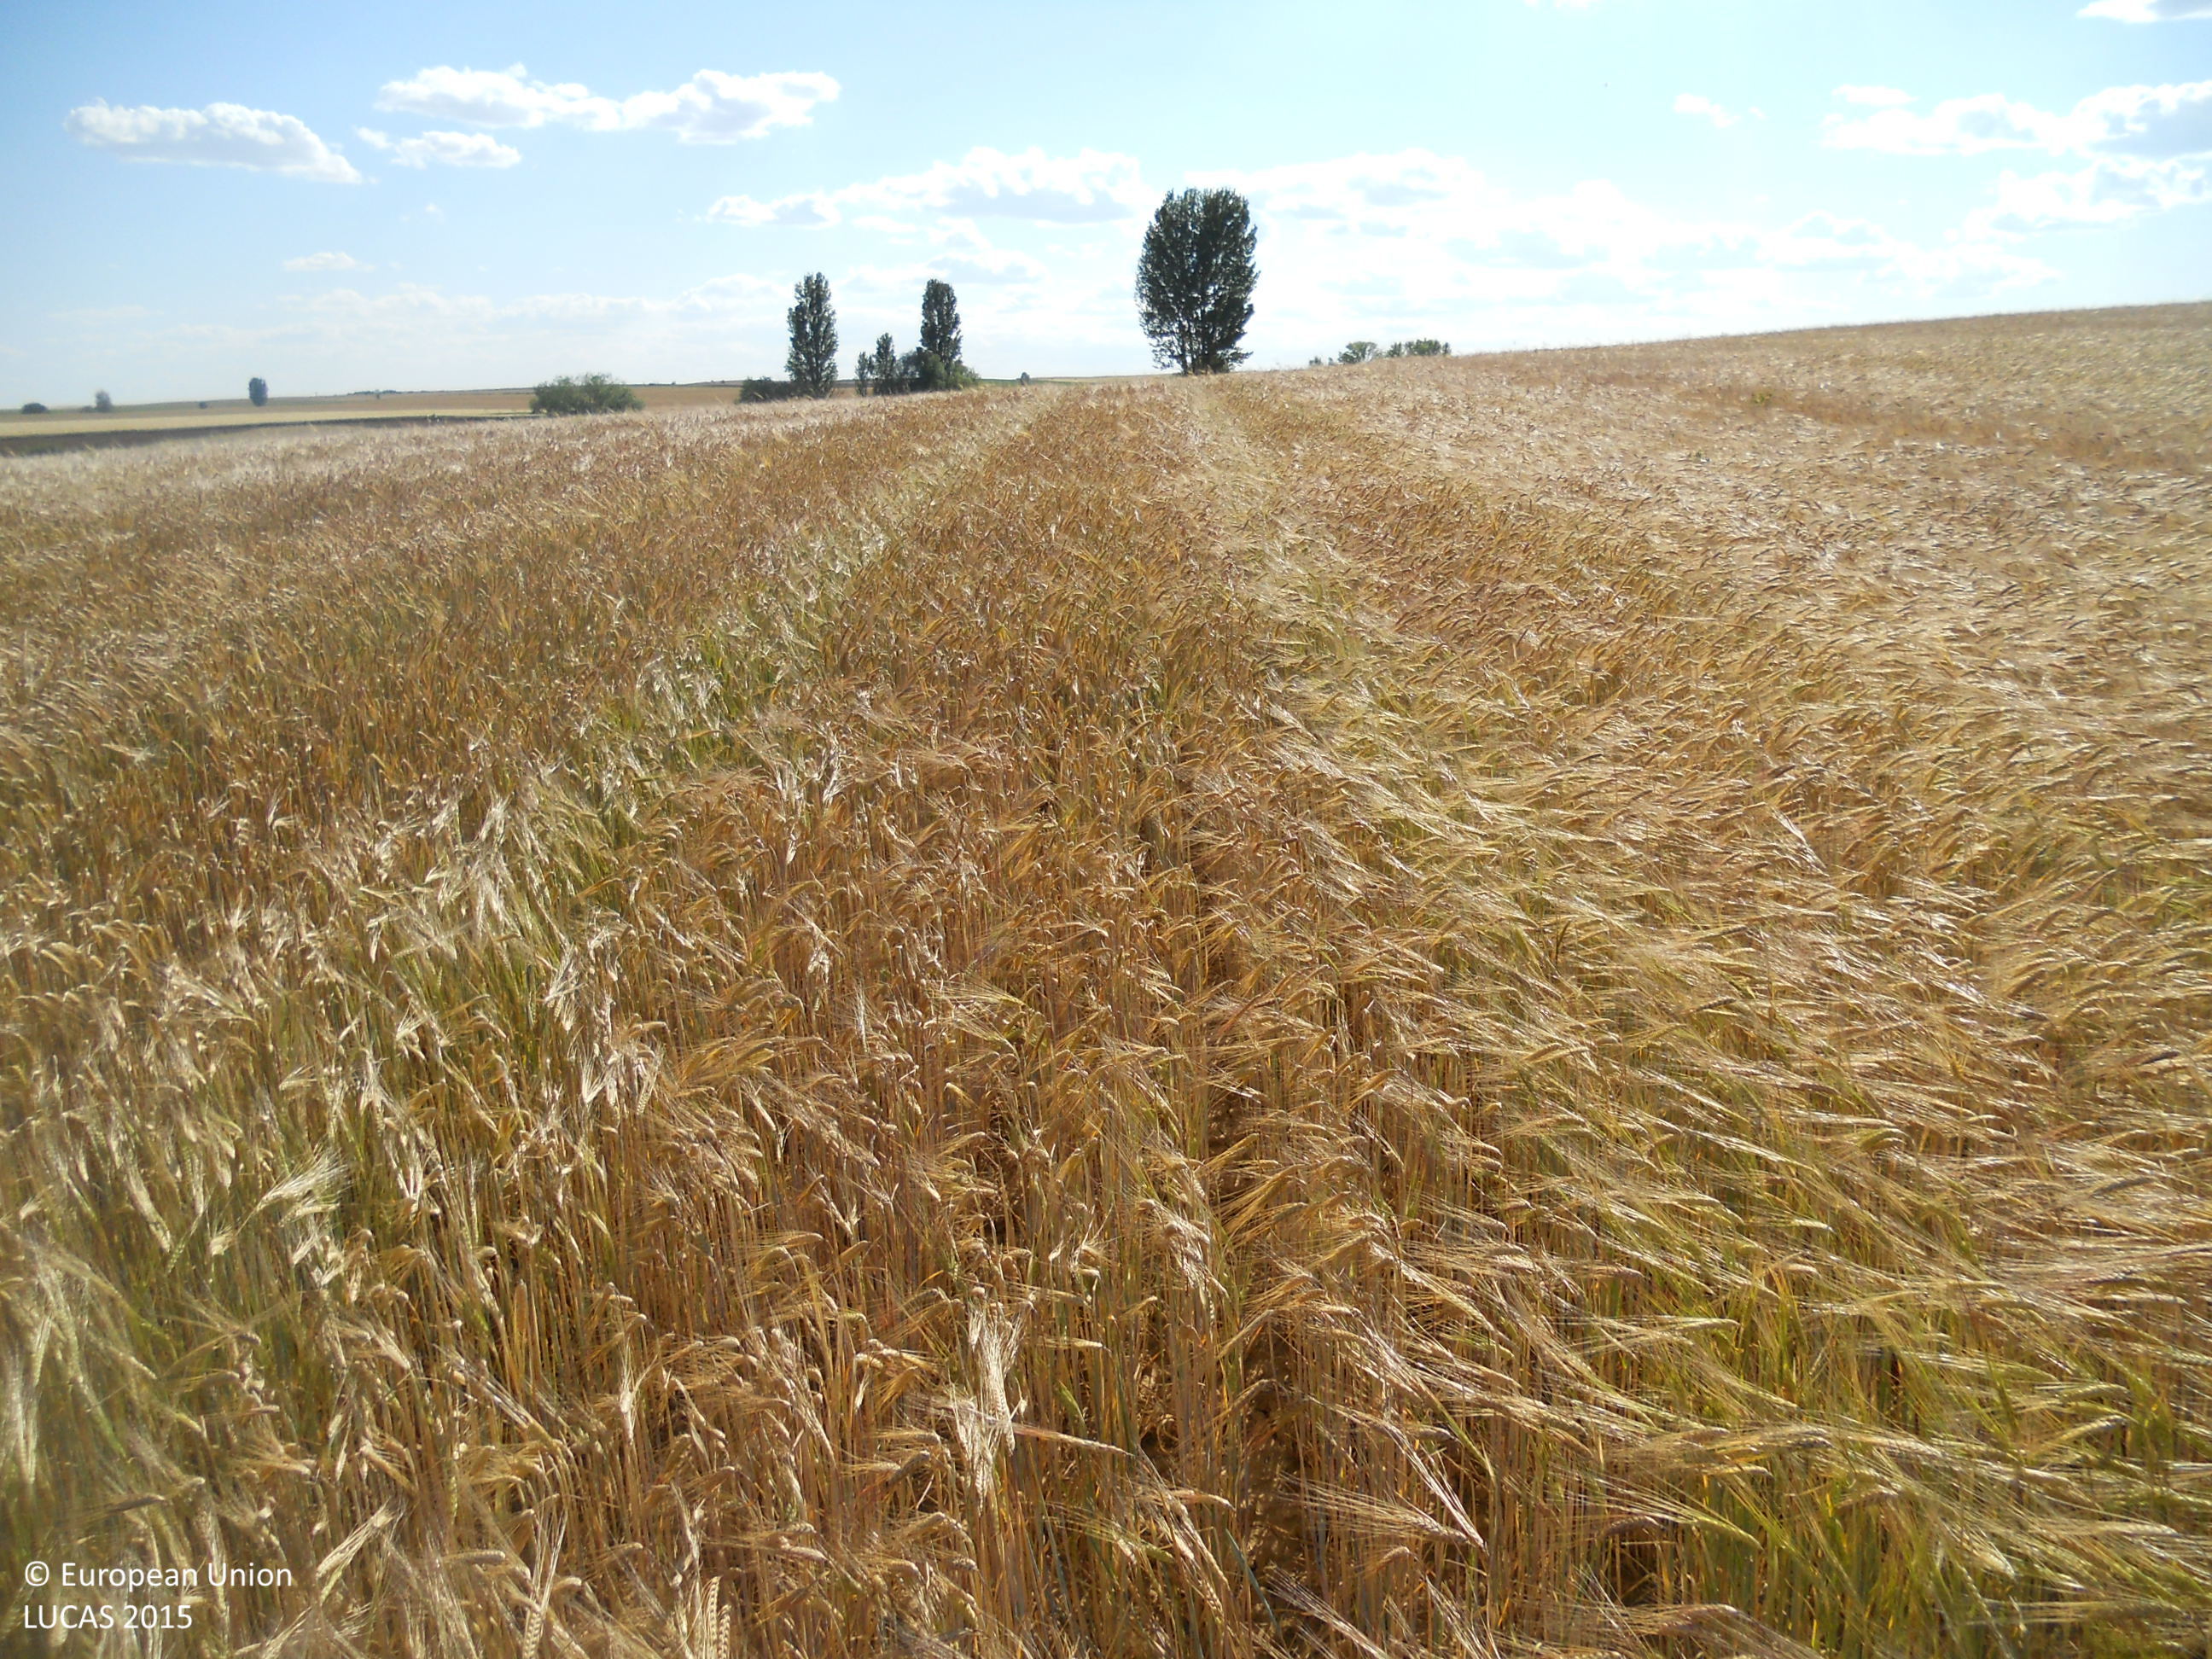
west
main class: Cropland
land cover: Barley
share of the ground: > 75 %
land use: Agriculture (excluding fallow land and kitchen gardens)
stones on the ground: < 10 %
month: May
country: ES
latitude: 42.3015
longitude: -4.8664
